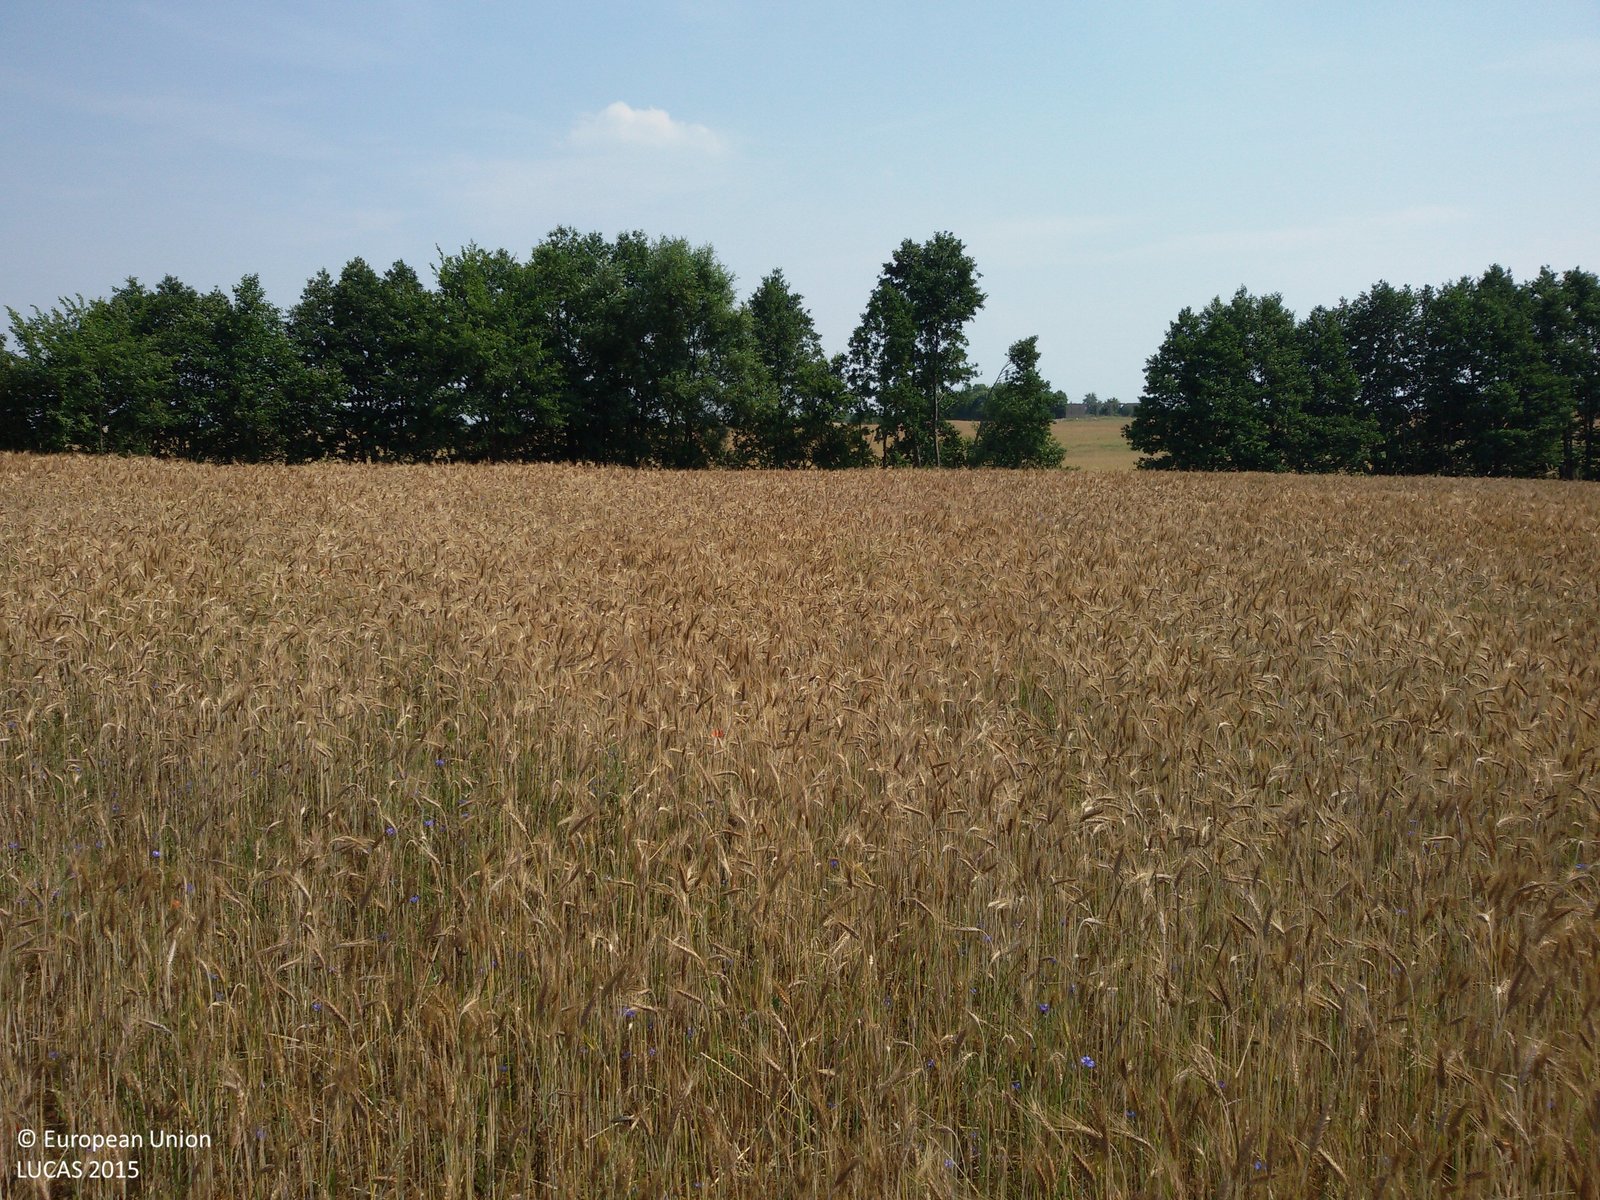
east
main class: Cropland
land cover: Triticale
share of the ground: > 75 %
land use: Agriculture (excluding fallow land and kitchen gardens)
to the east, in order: Triticale; Abandoned hedges; Ditches and canals; Abandoned hedges; Rape and turnip rape
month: July
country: PL
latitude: 53.3042
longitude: 17.6510
